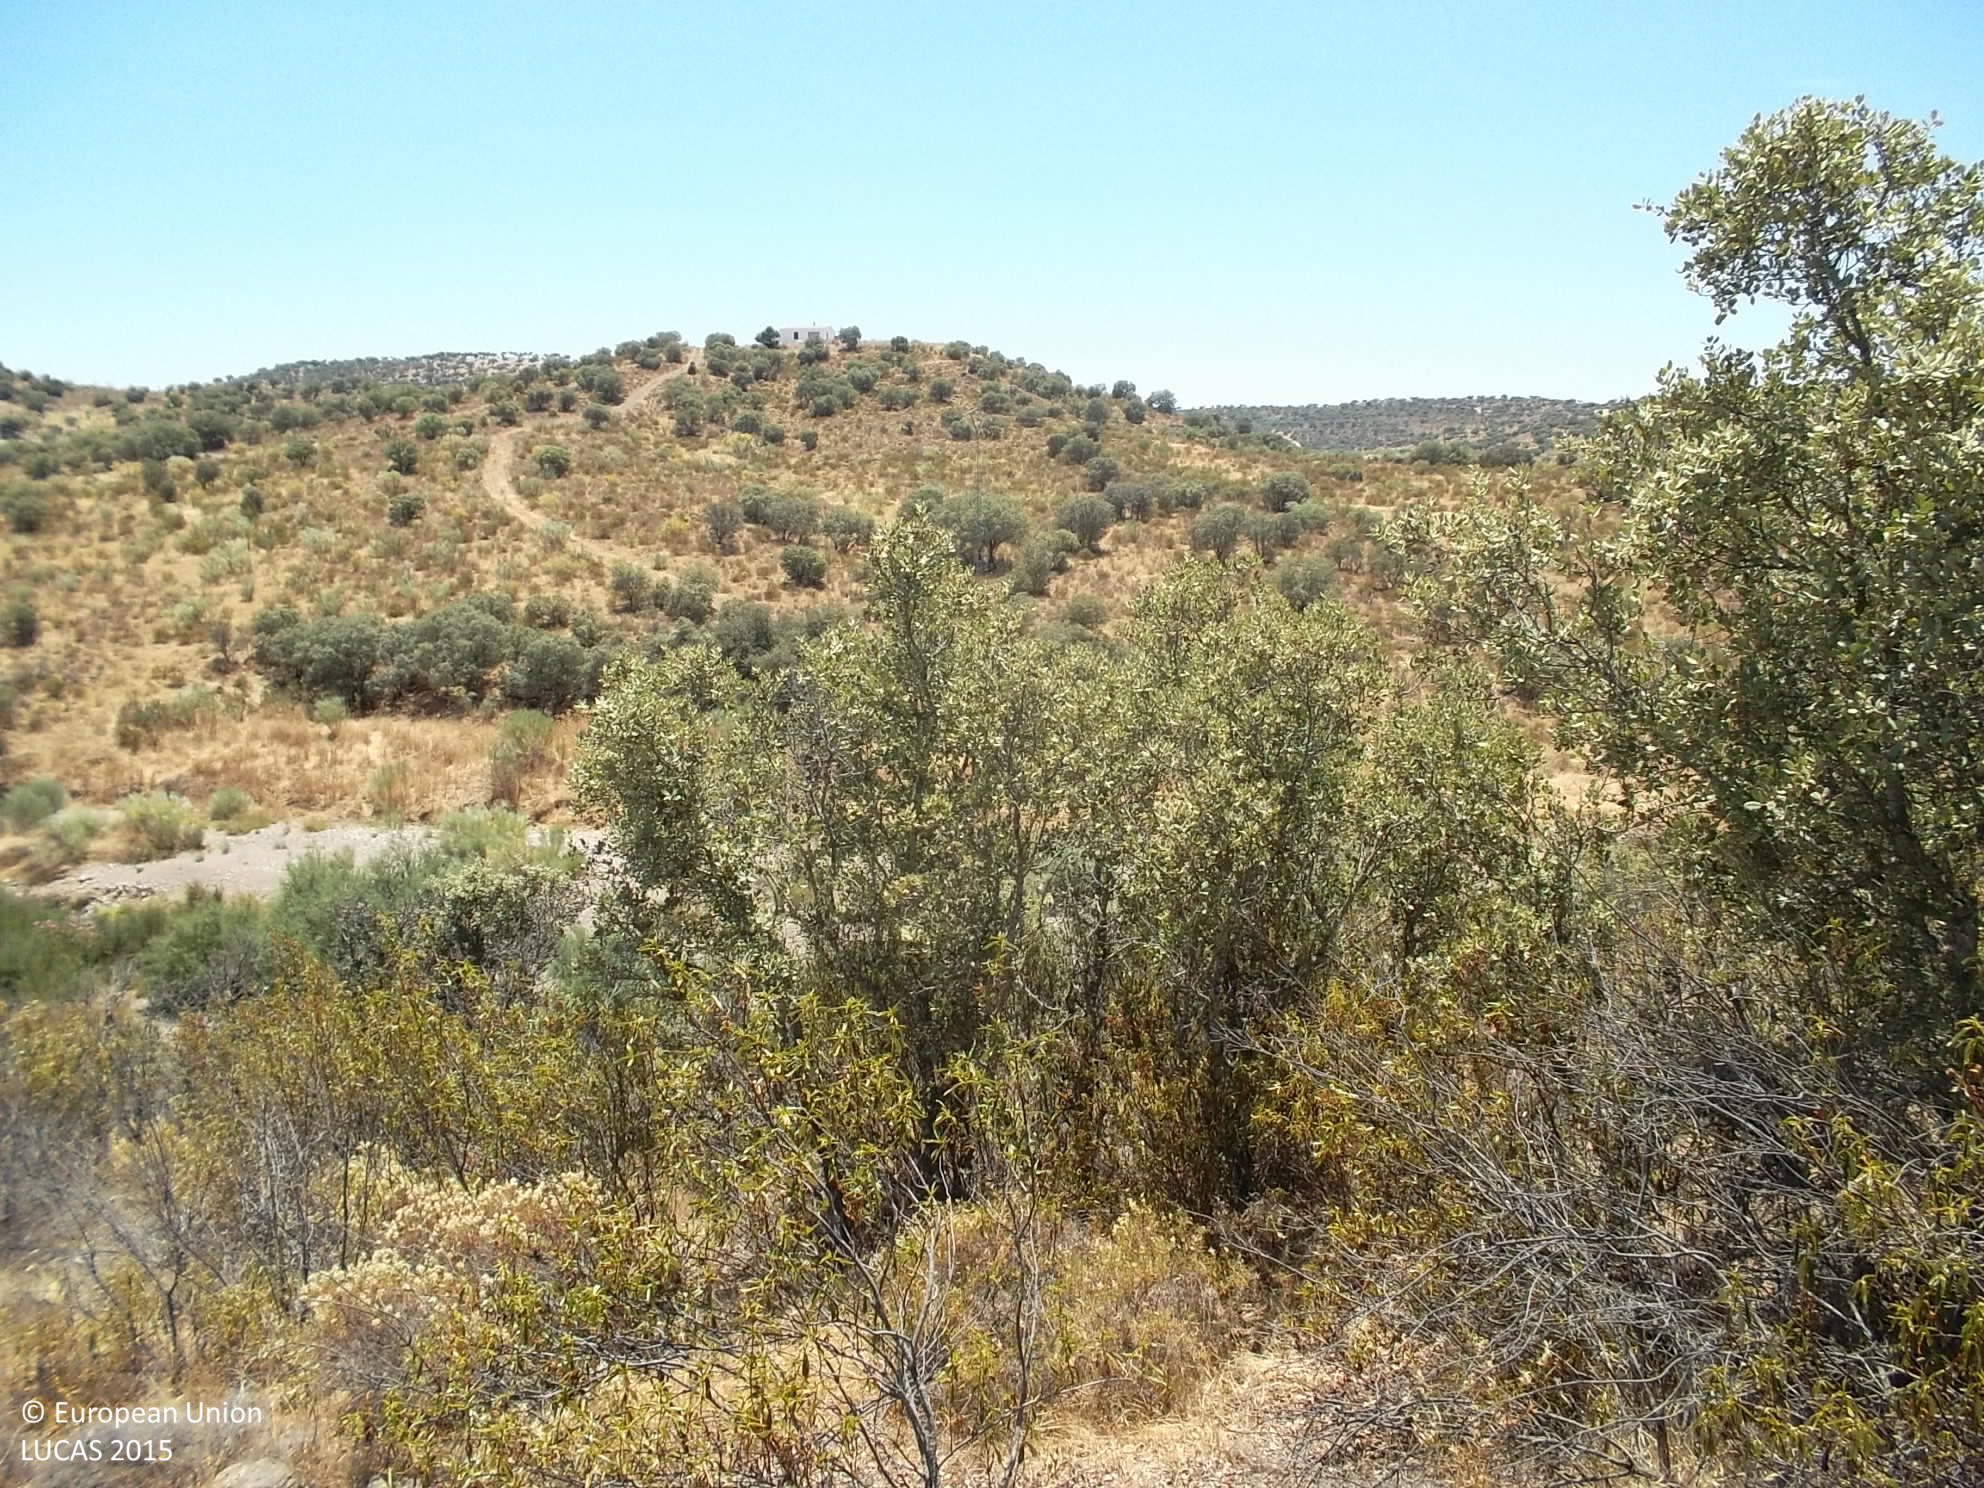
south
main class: Woodland
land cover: Broadleaved woodland
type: broadleaved evergreen forest
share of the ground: 25 - 50 %
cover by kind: shrubs 70 %, broadleaved forest trees 30 %
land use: Forestry
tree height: > 5 m
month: July
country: ES
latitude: 38.1871
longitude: -5.6859
